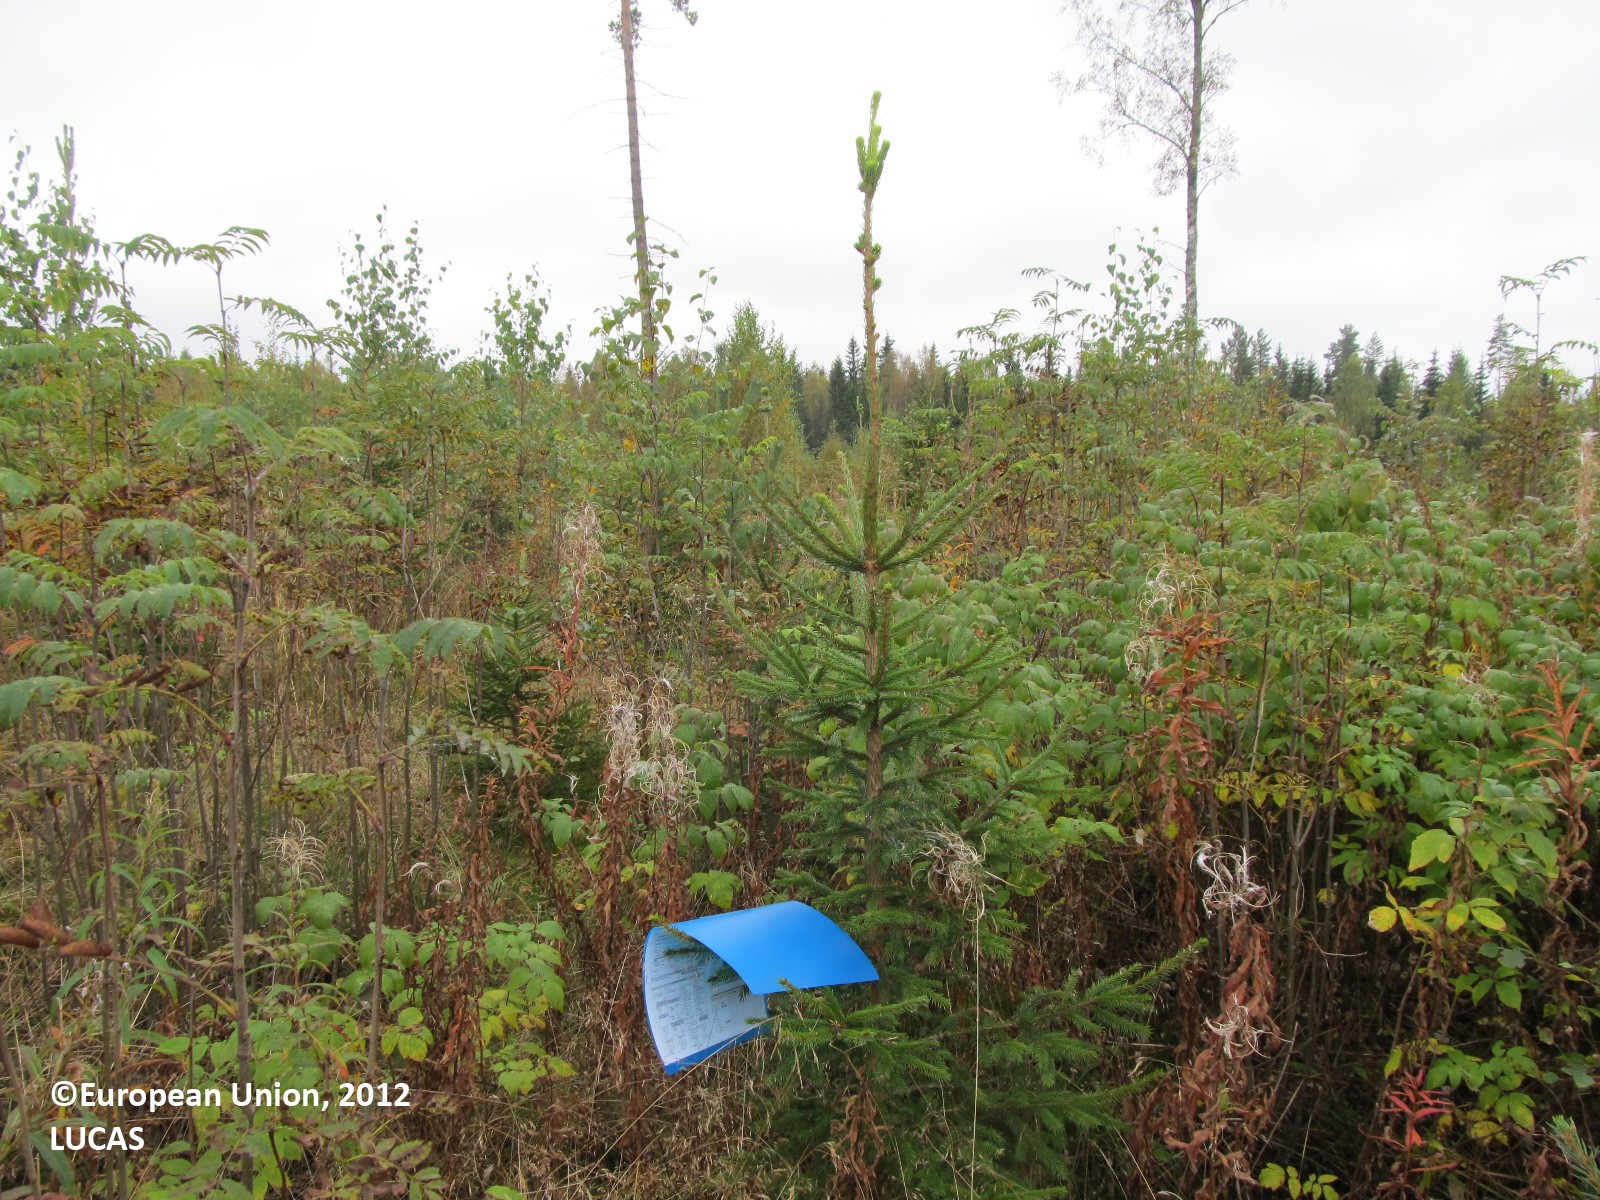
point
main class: Woodland
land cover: Spruce dominated mixed woodland
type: boreal forest
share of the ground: > 75 %
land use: Forestry
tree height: < 5 m
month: September
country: FI
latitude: 63.1222
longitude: 27.9186
